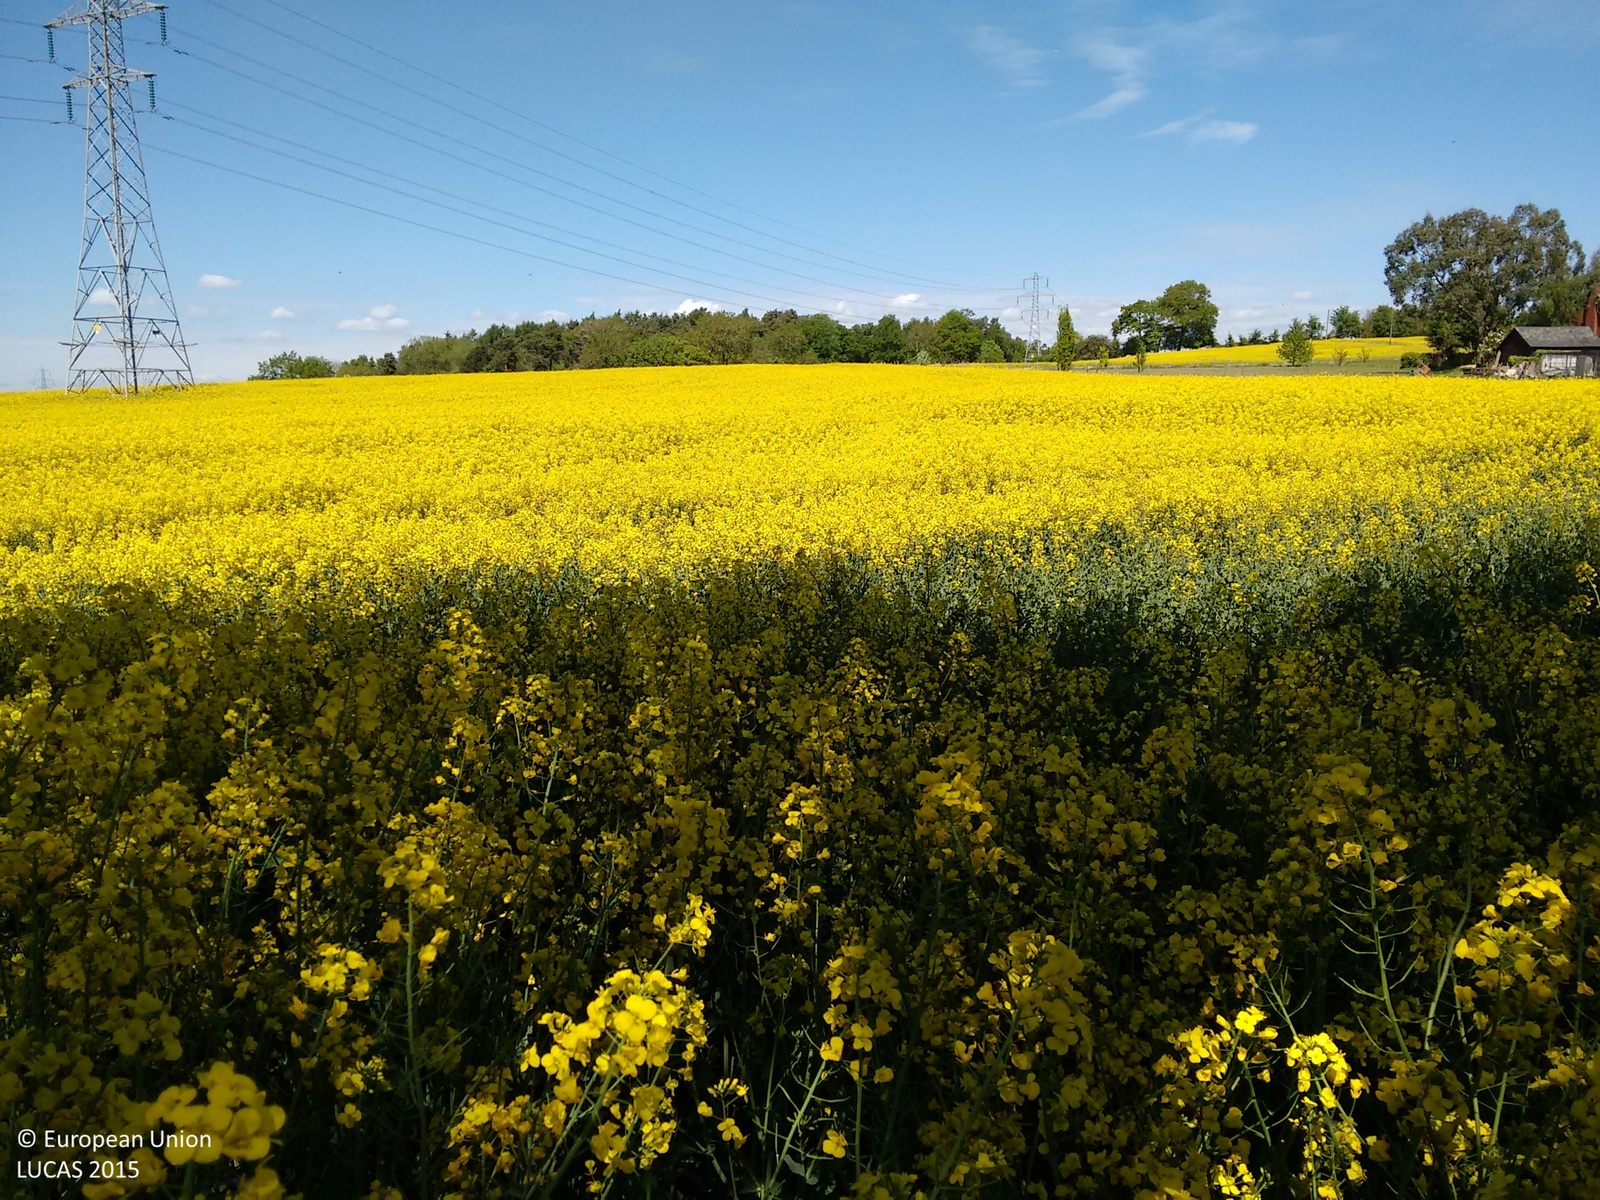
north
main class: Cropland
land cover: Rape and turnip rape
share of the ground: > 75 %
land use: Agriculture (excluding fallow land and kitchen gardens)
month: May
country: GB
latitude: 51.3508
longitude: -1.0582
